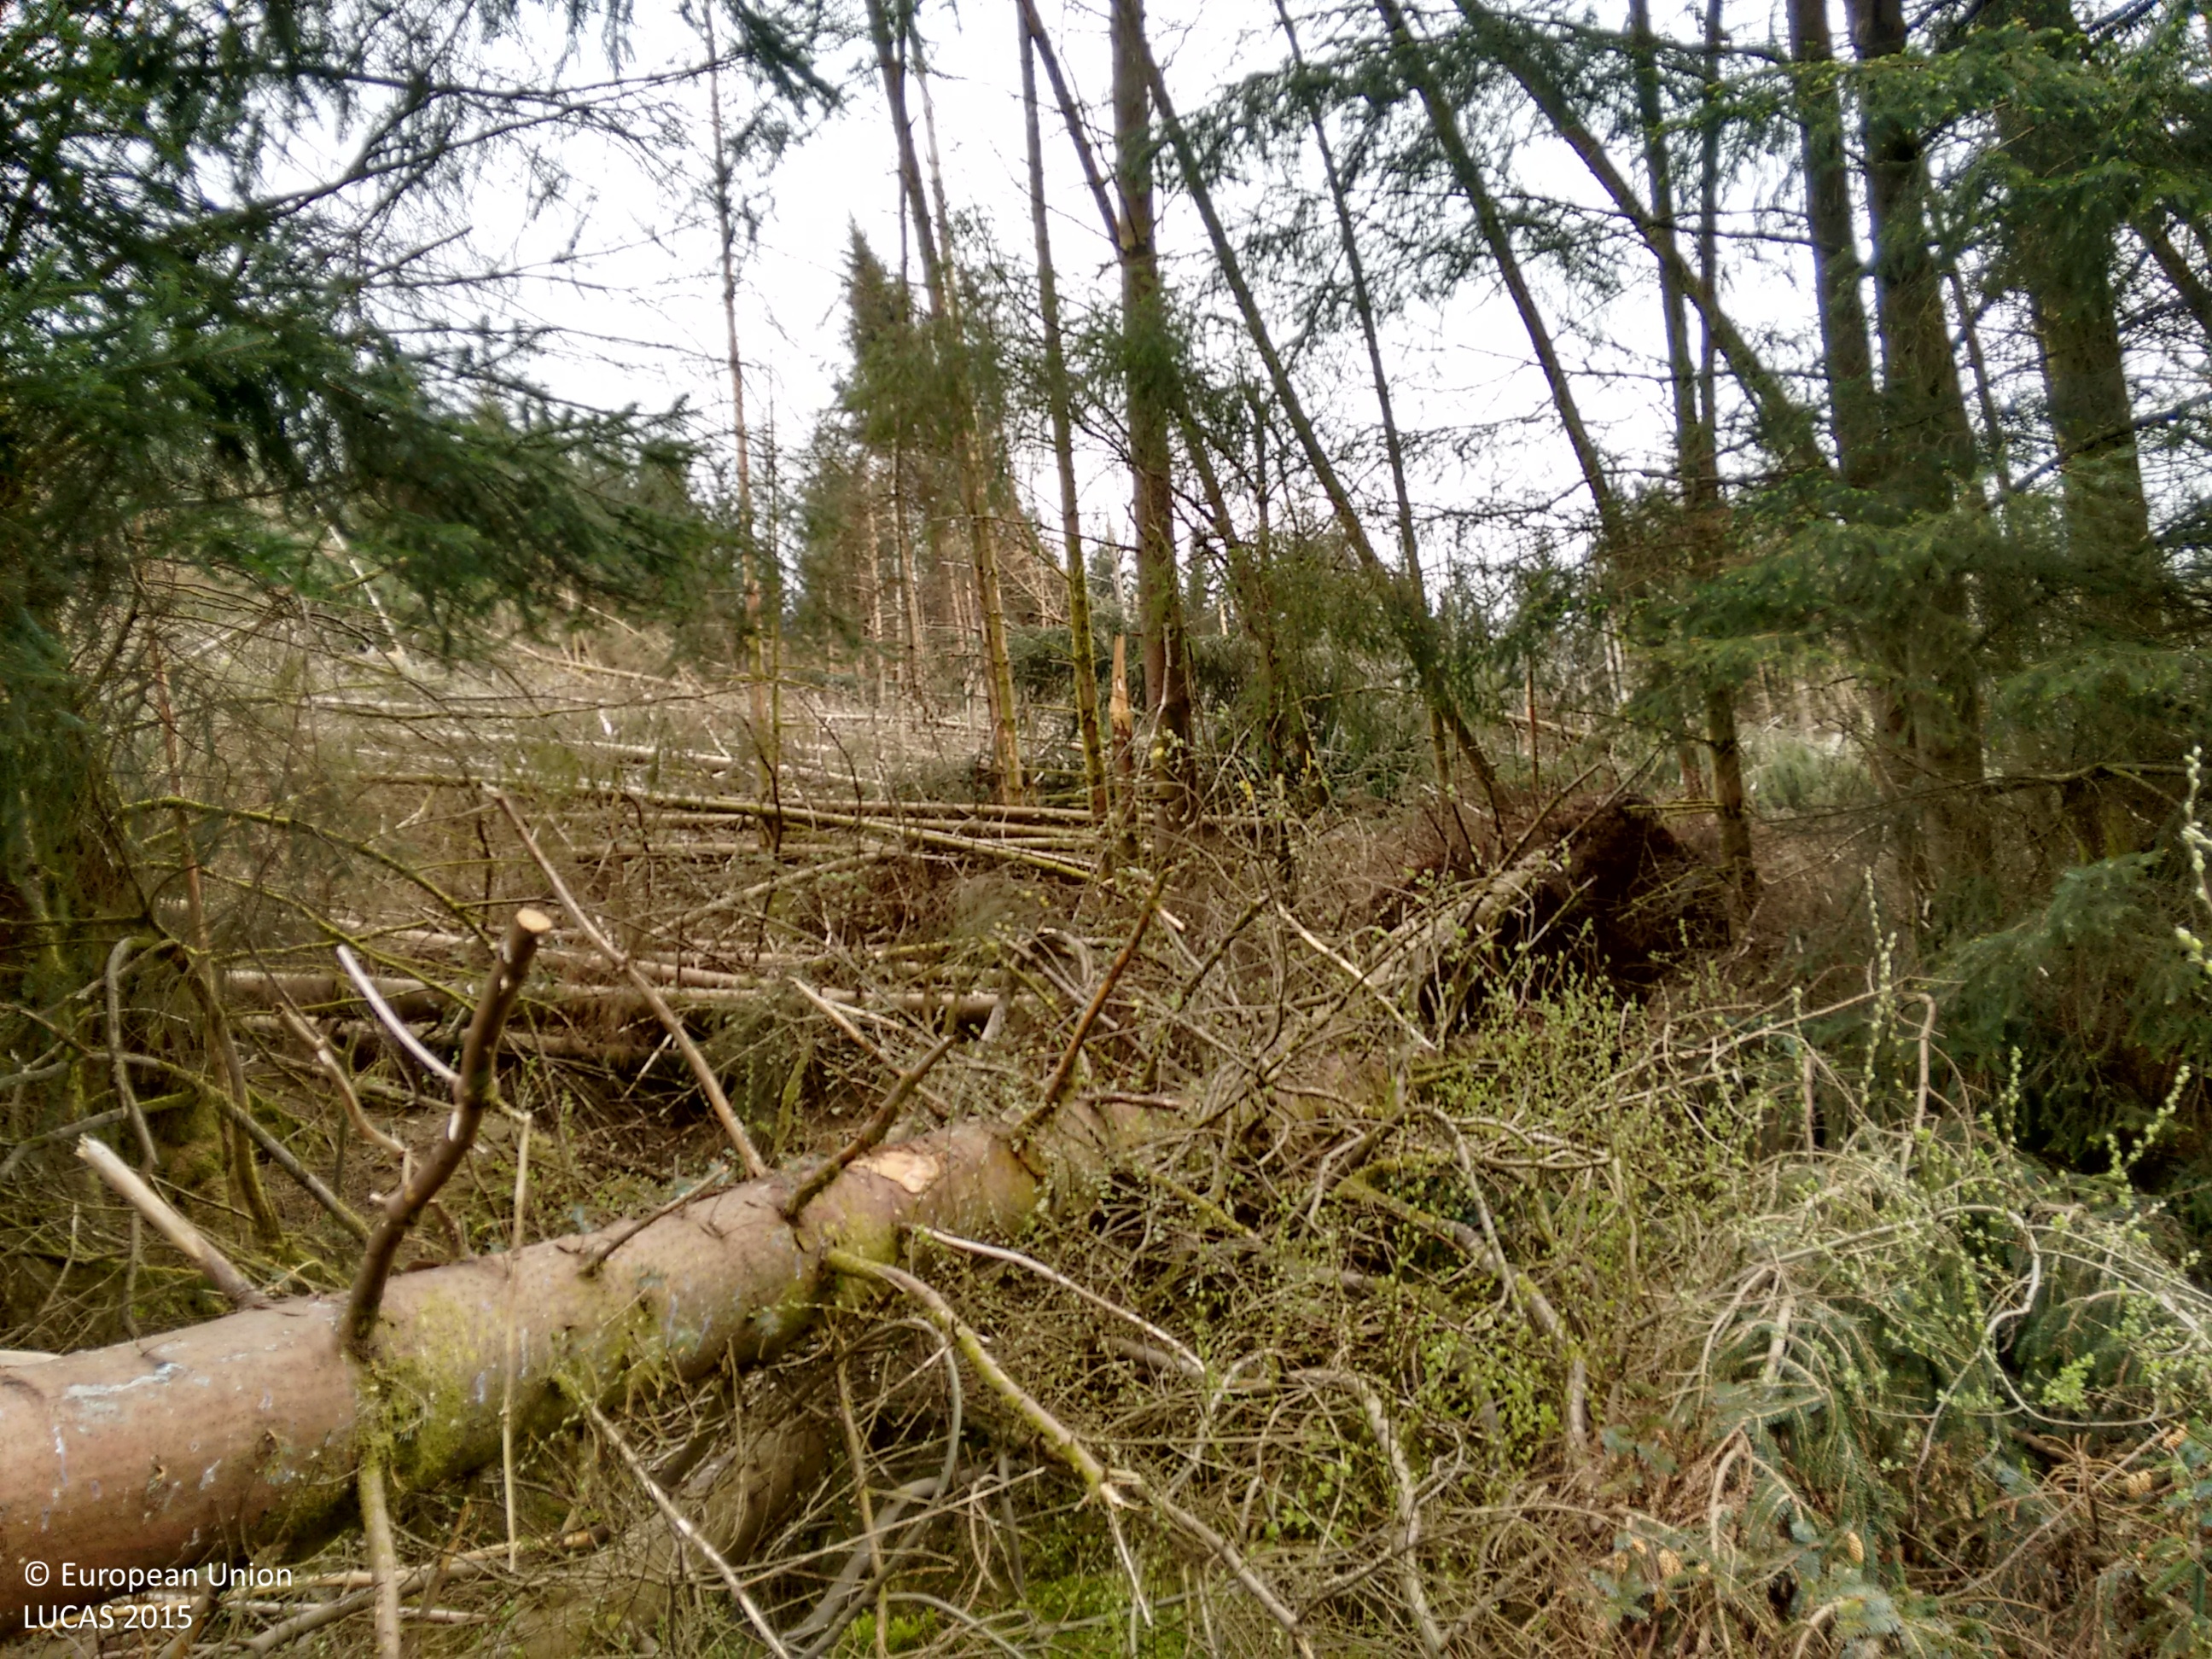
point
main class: Woodland
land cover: Spruce dominated coniferous woodland
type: exotic forest
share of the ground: > 75 %
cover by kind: coniferous forest trees 30 %, shrubs 25 %
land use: Forestry
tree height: > 5 m
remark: Clear cut
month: May
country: GB
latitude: 56.1168
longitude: -4.4263
